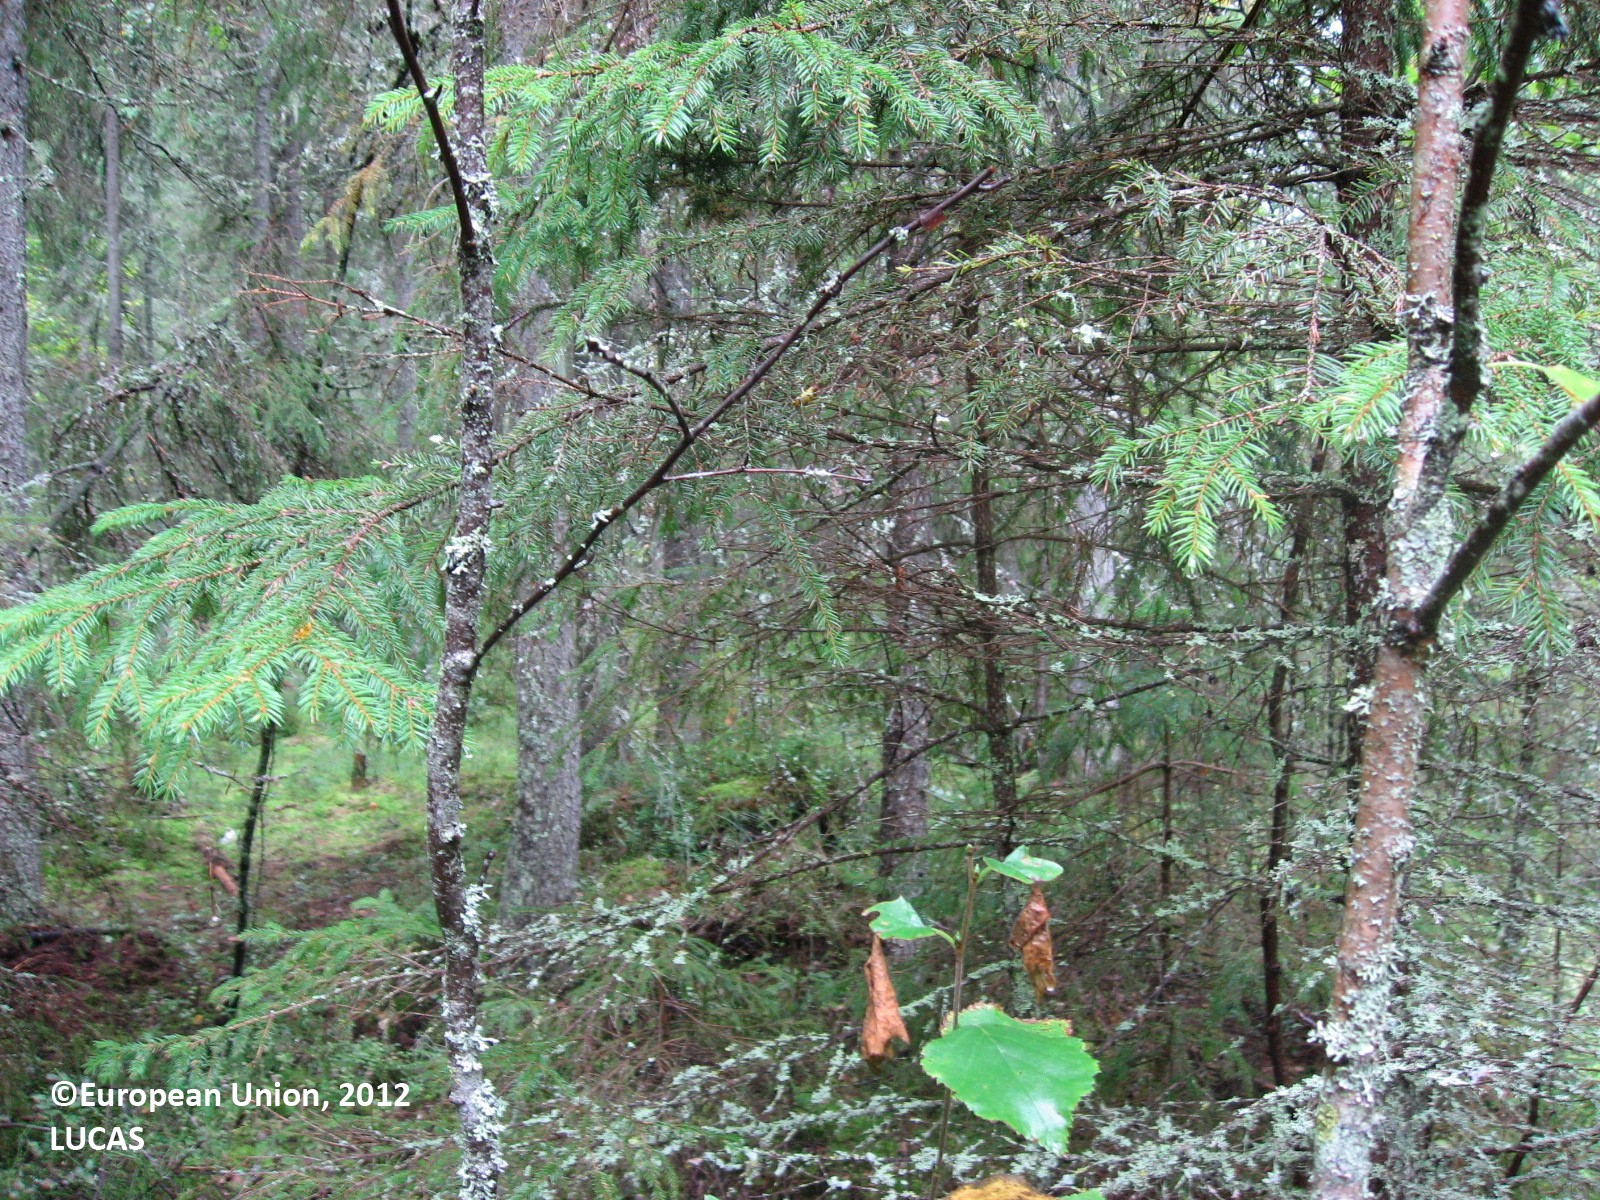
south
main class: Woodland
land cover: Spruce dominated mixed woodland
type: boreal forest
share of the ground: 50 - 75 %
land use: Forestry
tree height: > 5 m
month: August
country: FI
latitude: 61.4901
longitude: 24.9643
